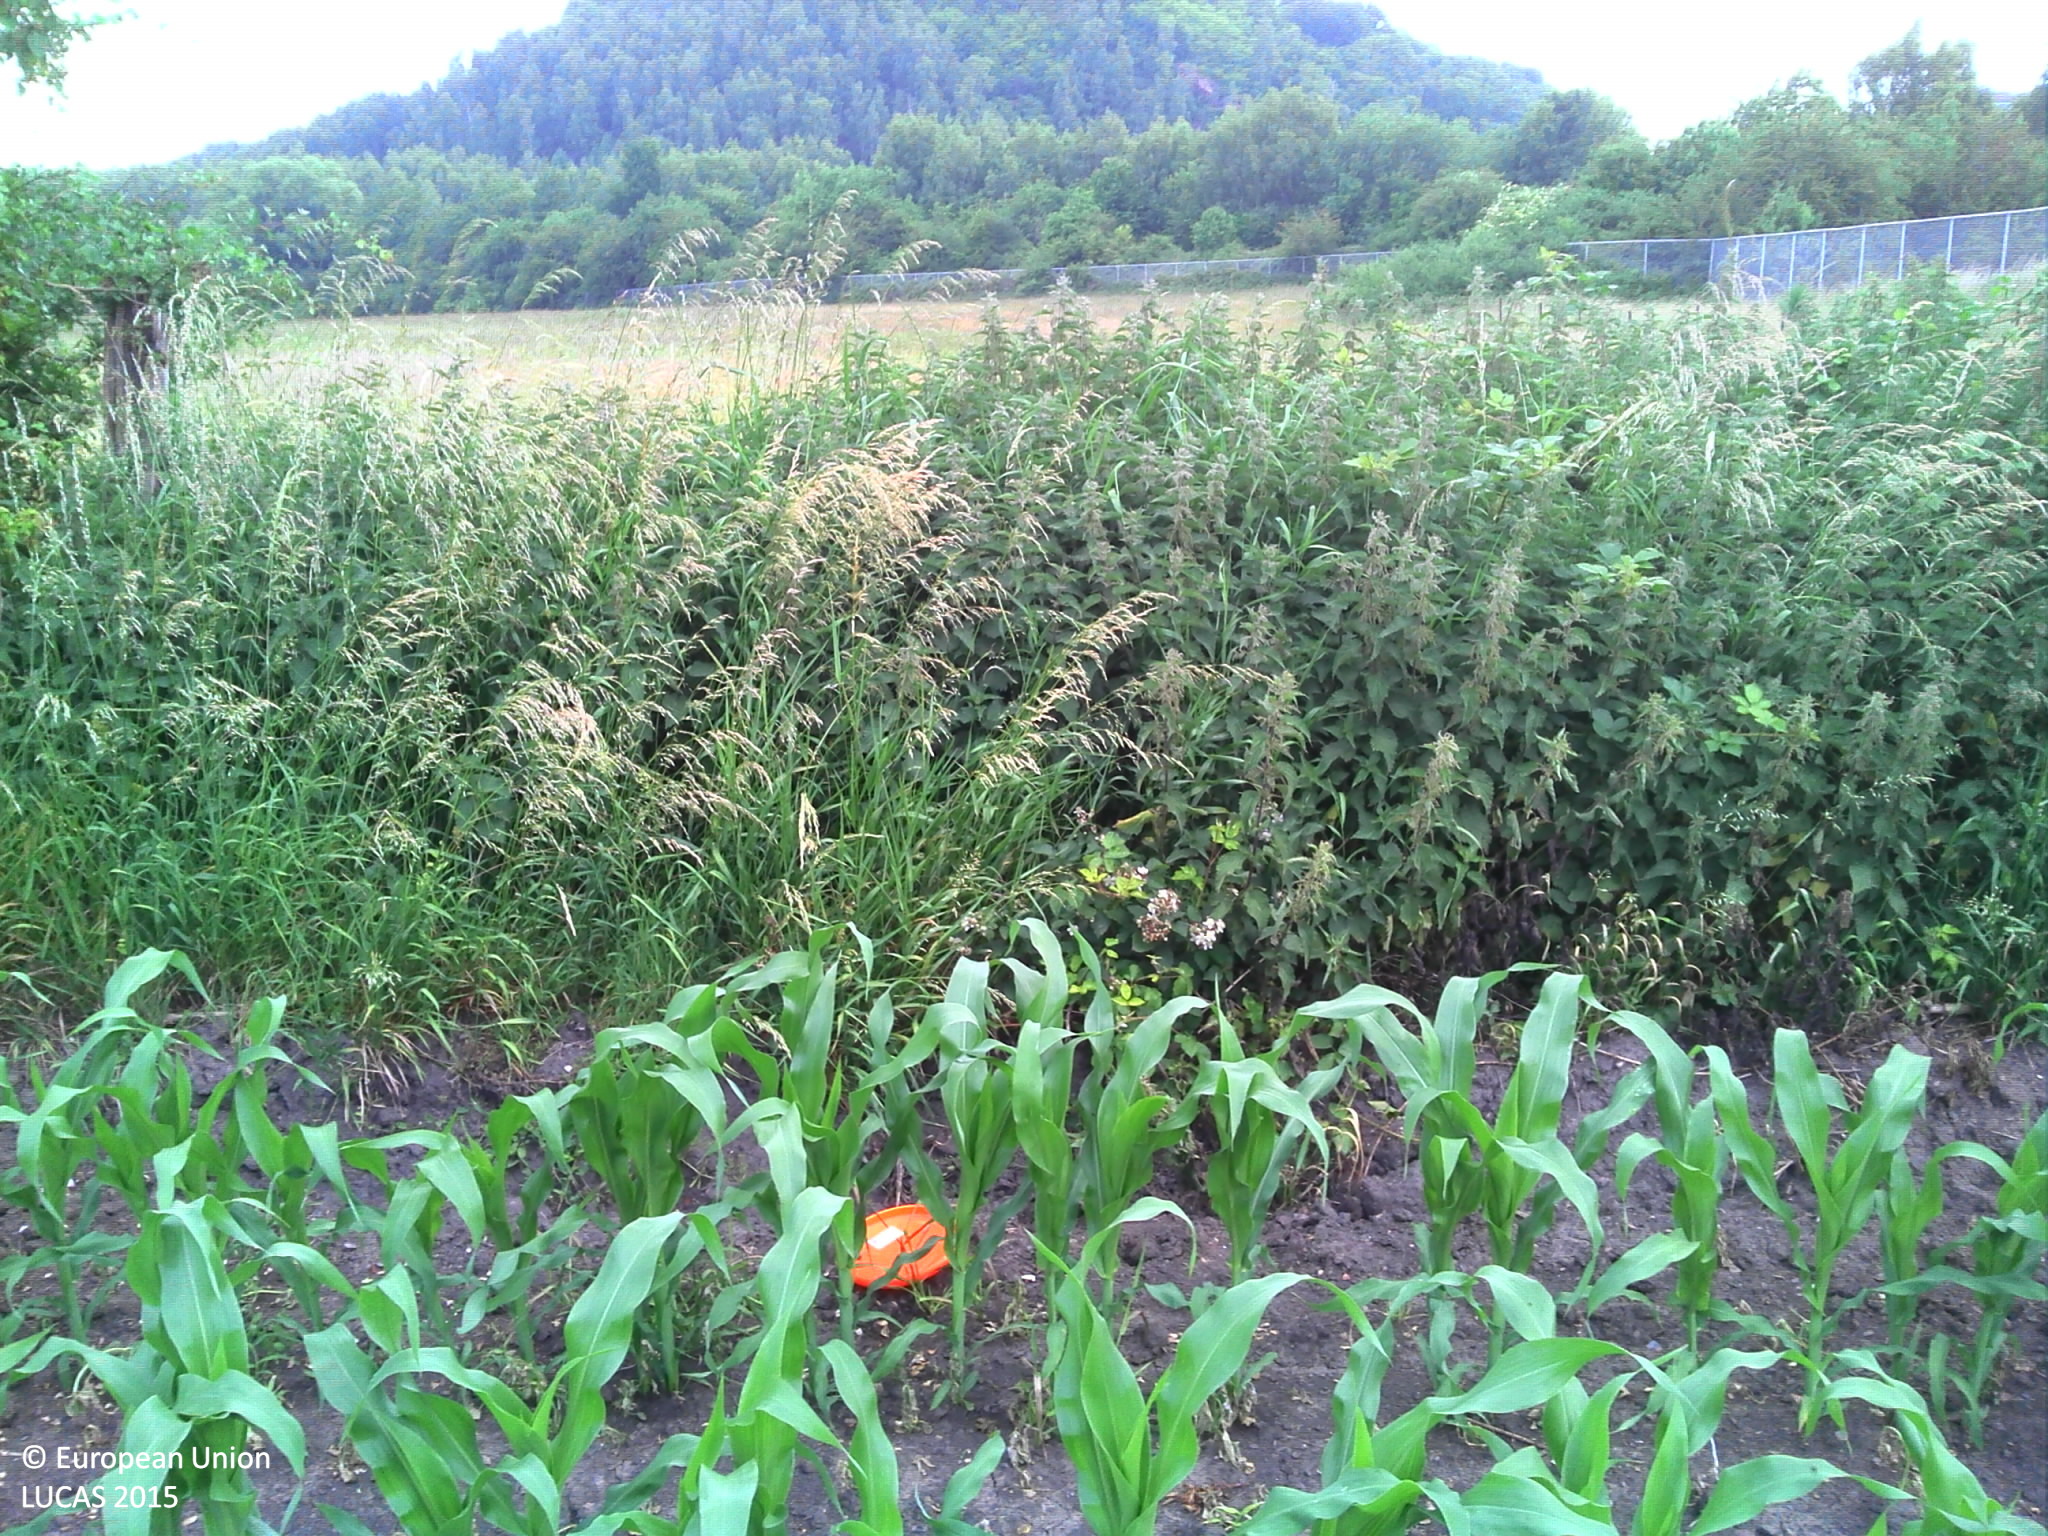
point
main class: Cropland
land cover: Maize
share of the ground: 25 - 50 %
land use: Agriculture (excluding fallow land and kitchen gardens)
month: June
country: BE
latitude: 50.4177
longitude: 3.8999
